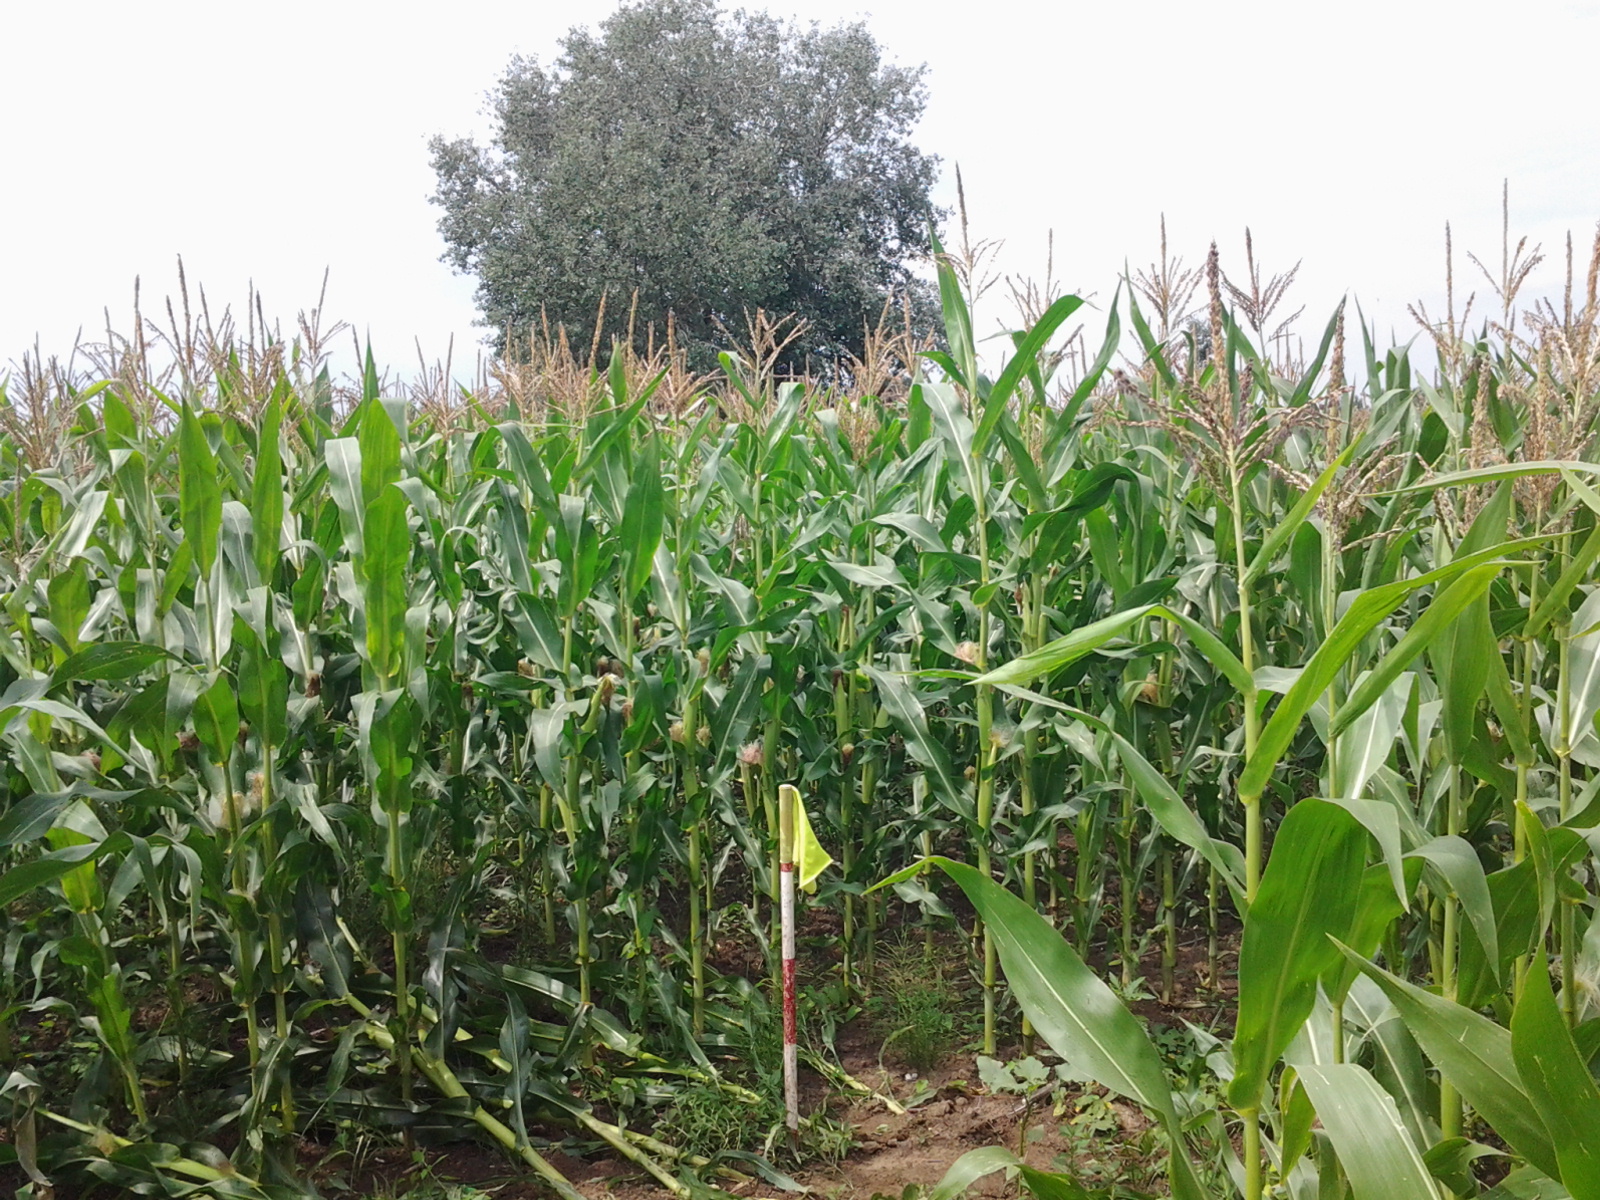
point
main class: Cropland
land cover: Maize
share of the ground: > 75 %
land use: Agriculture (excluding fallow land and kitchen gardens)
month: June
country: HU
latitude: 47.1180
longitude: 20.1615
